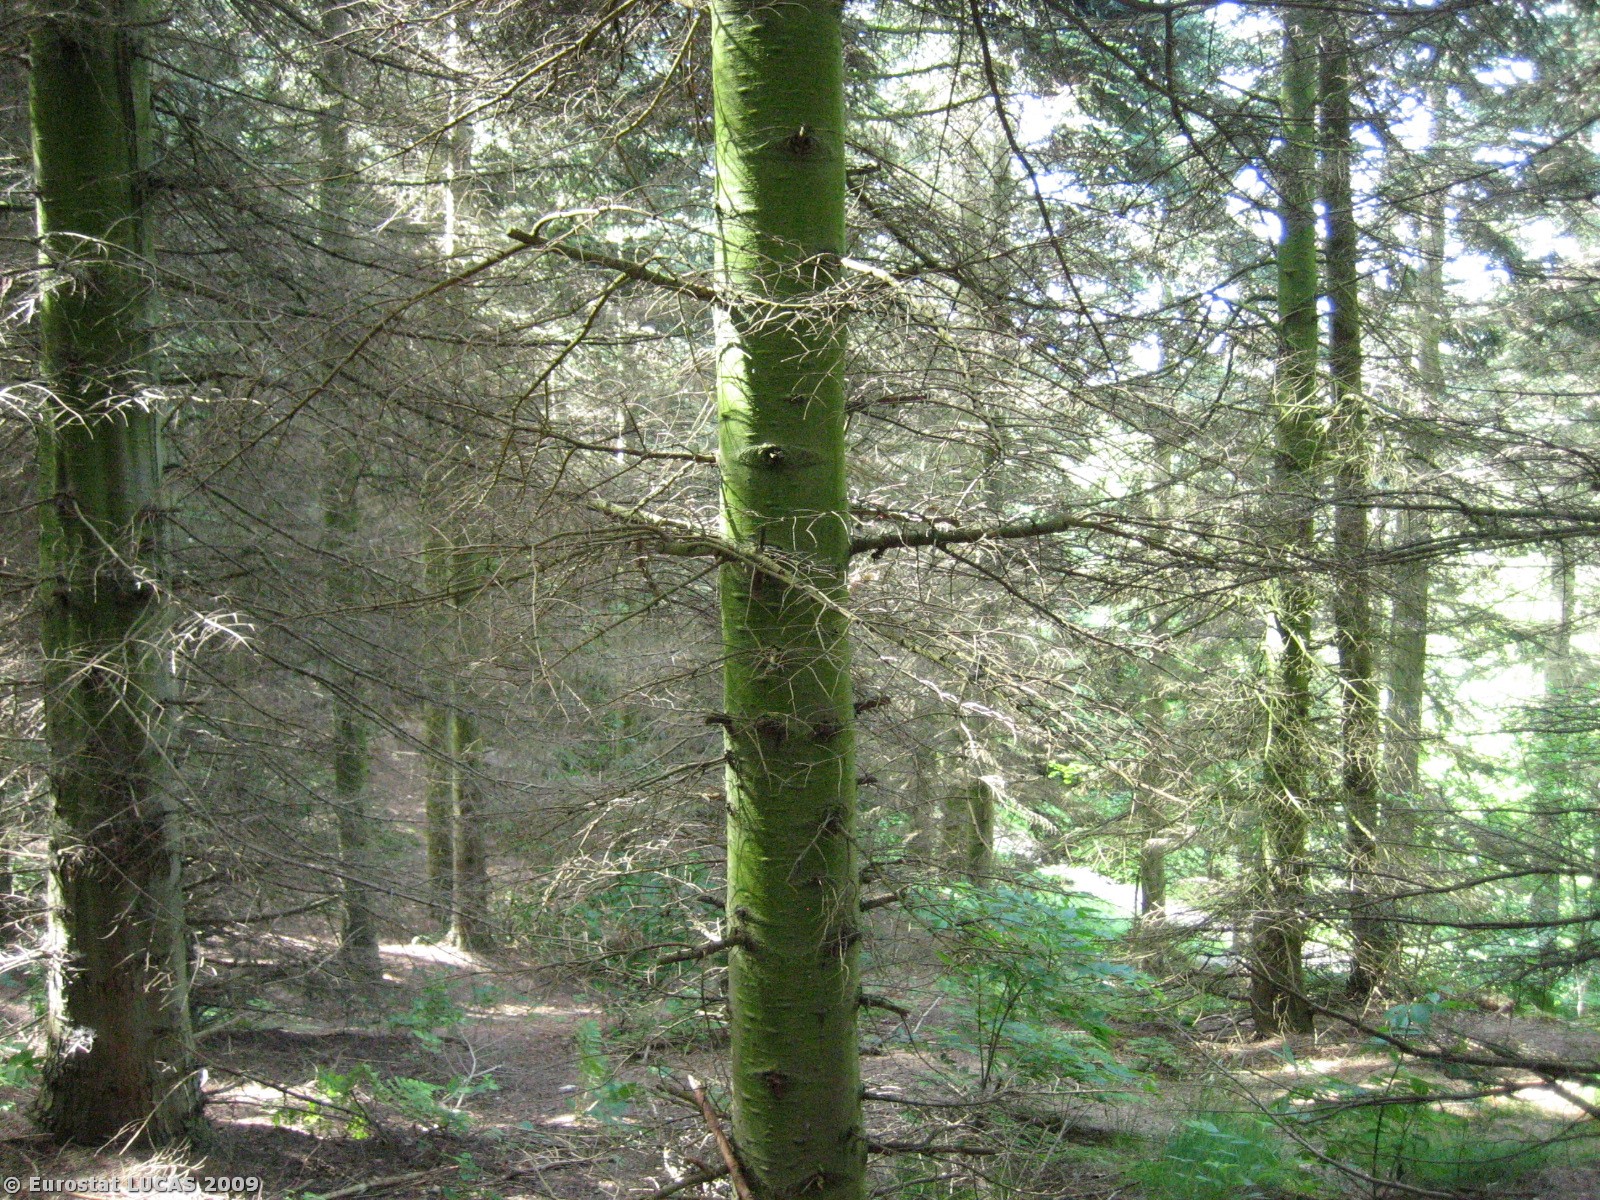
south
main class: Woodland
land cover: Coniferous woodland
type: hemiboreal forest and nemoral coniferous forest and mixed broadleaved-coniferous forest
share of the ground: > 75 %
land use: Forestry
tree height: > 5 m
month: June
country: DK
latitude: 55.7922
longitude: 9.8566
